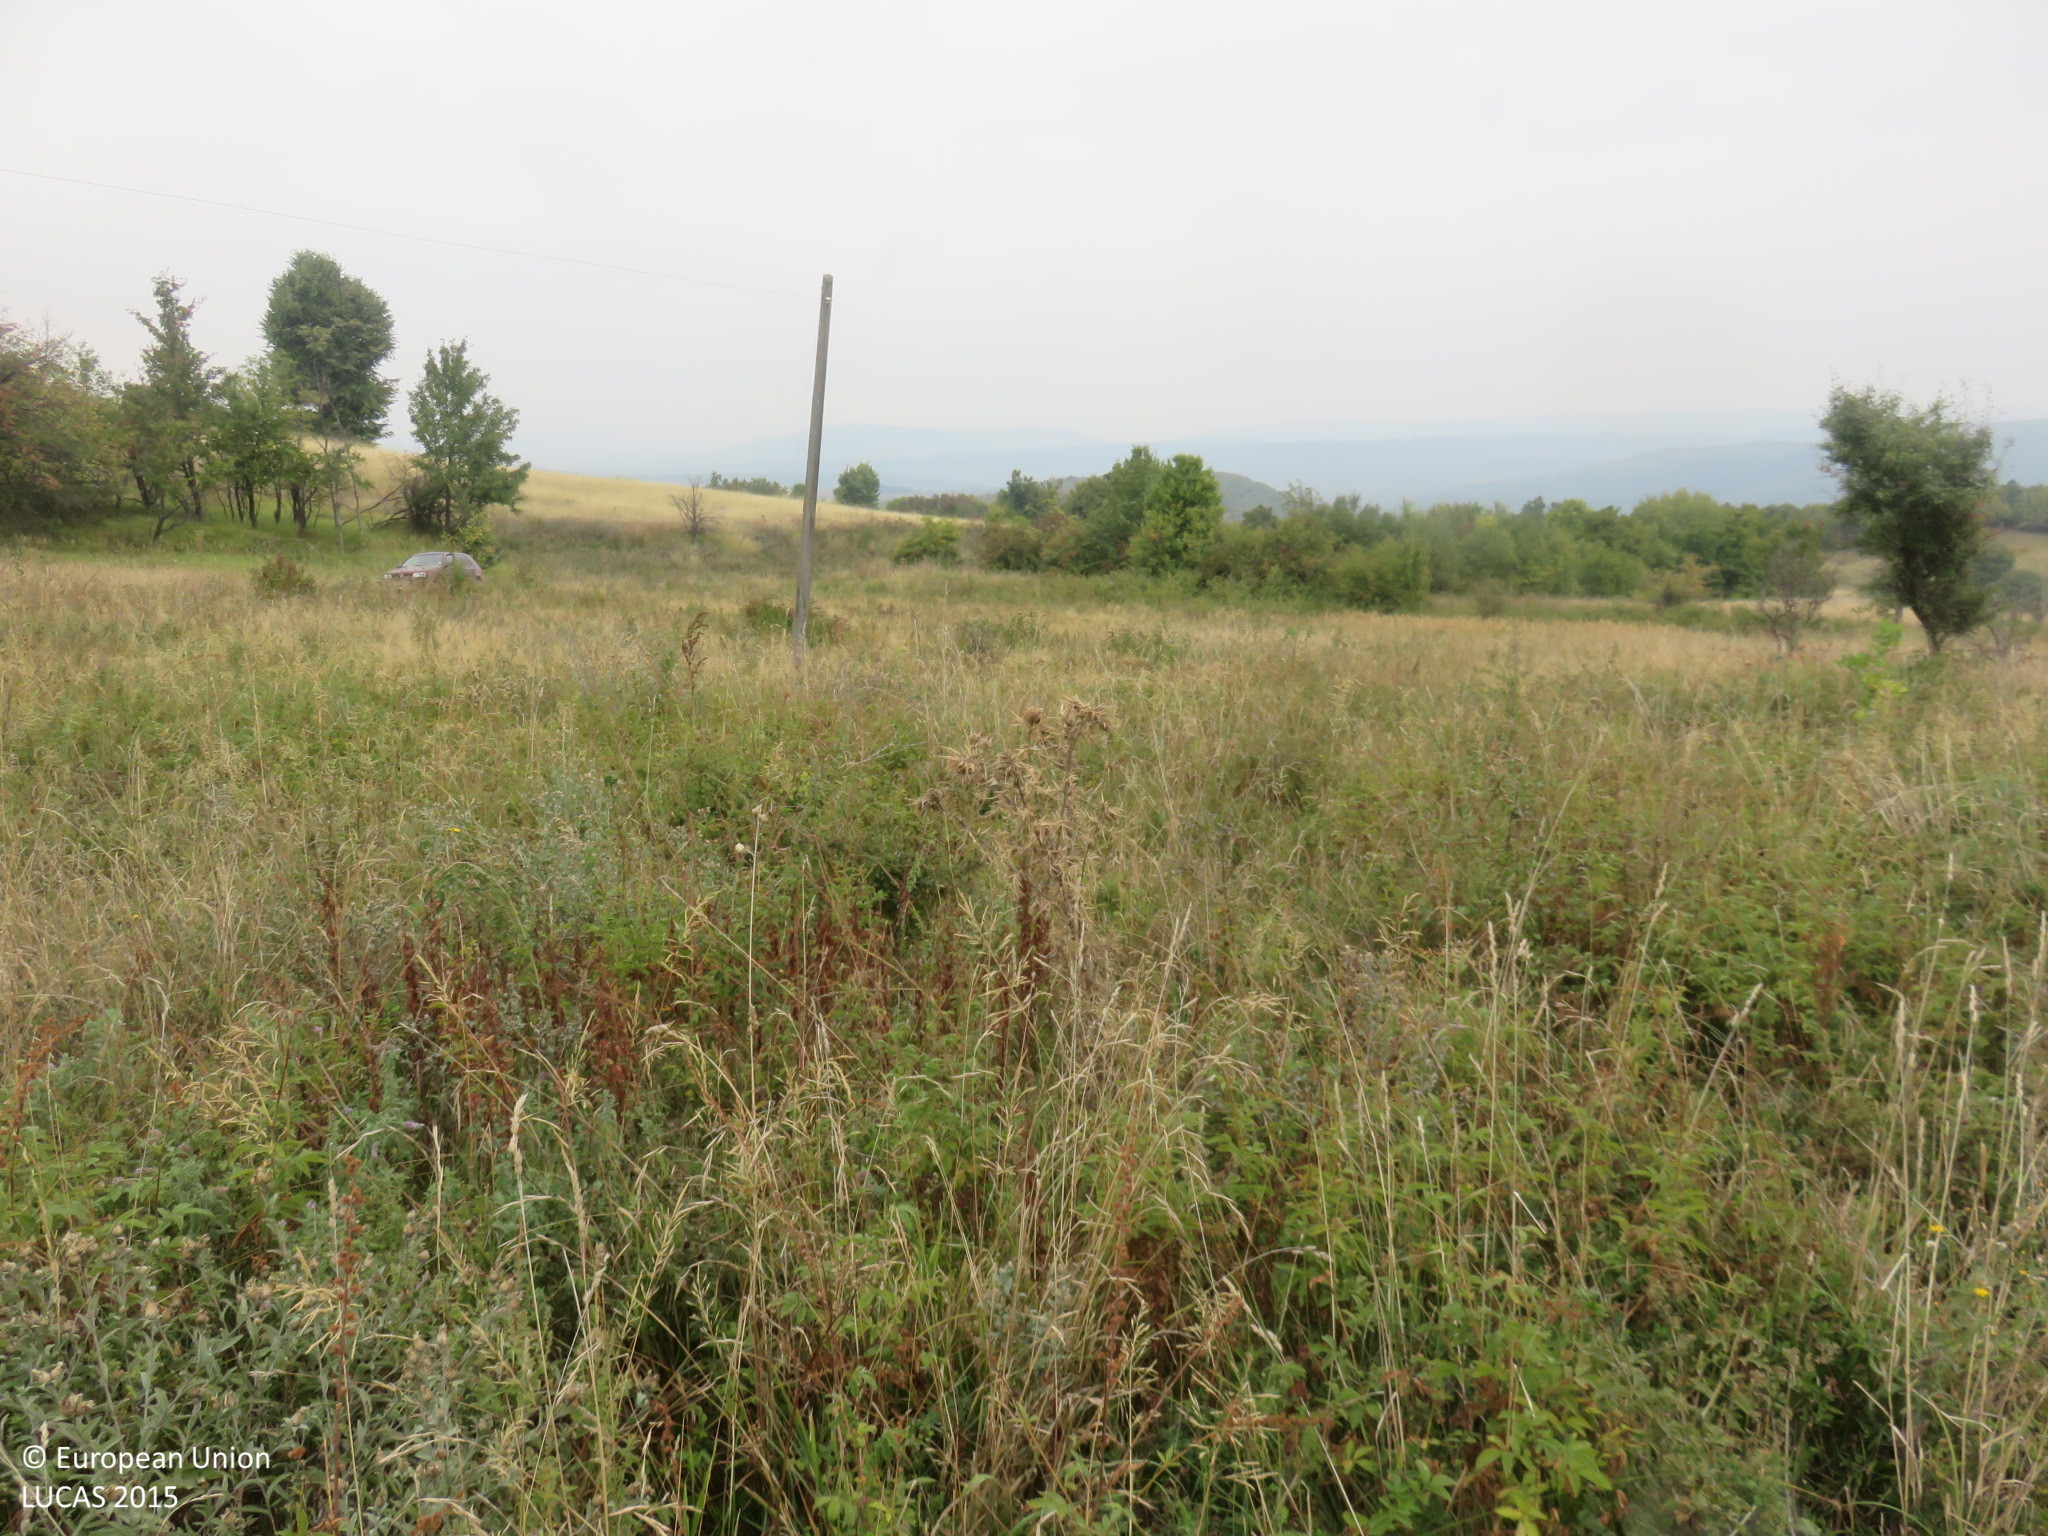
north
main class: Grassland
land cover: Grassland without tree/shrub cover
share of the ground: > 75 %
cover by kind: herbaceous plants 100 %
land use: Agriculture (excluding fallow land and kitchen gardens)
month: September
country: BG
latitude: 43.1141
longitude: 24.8234
